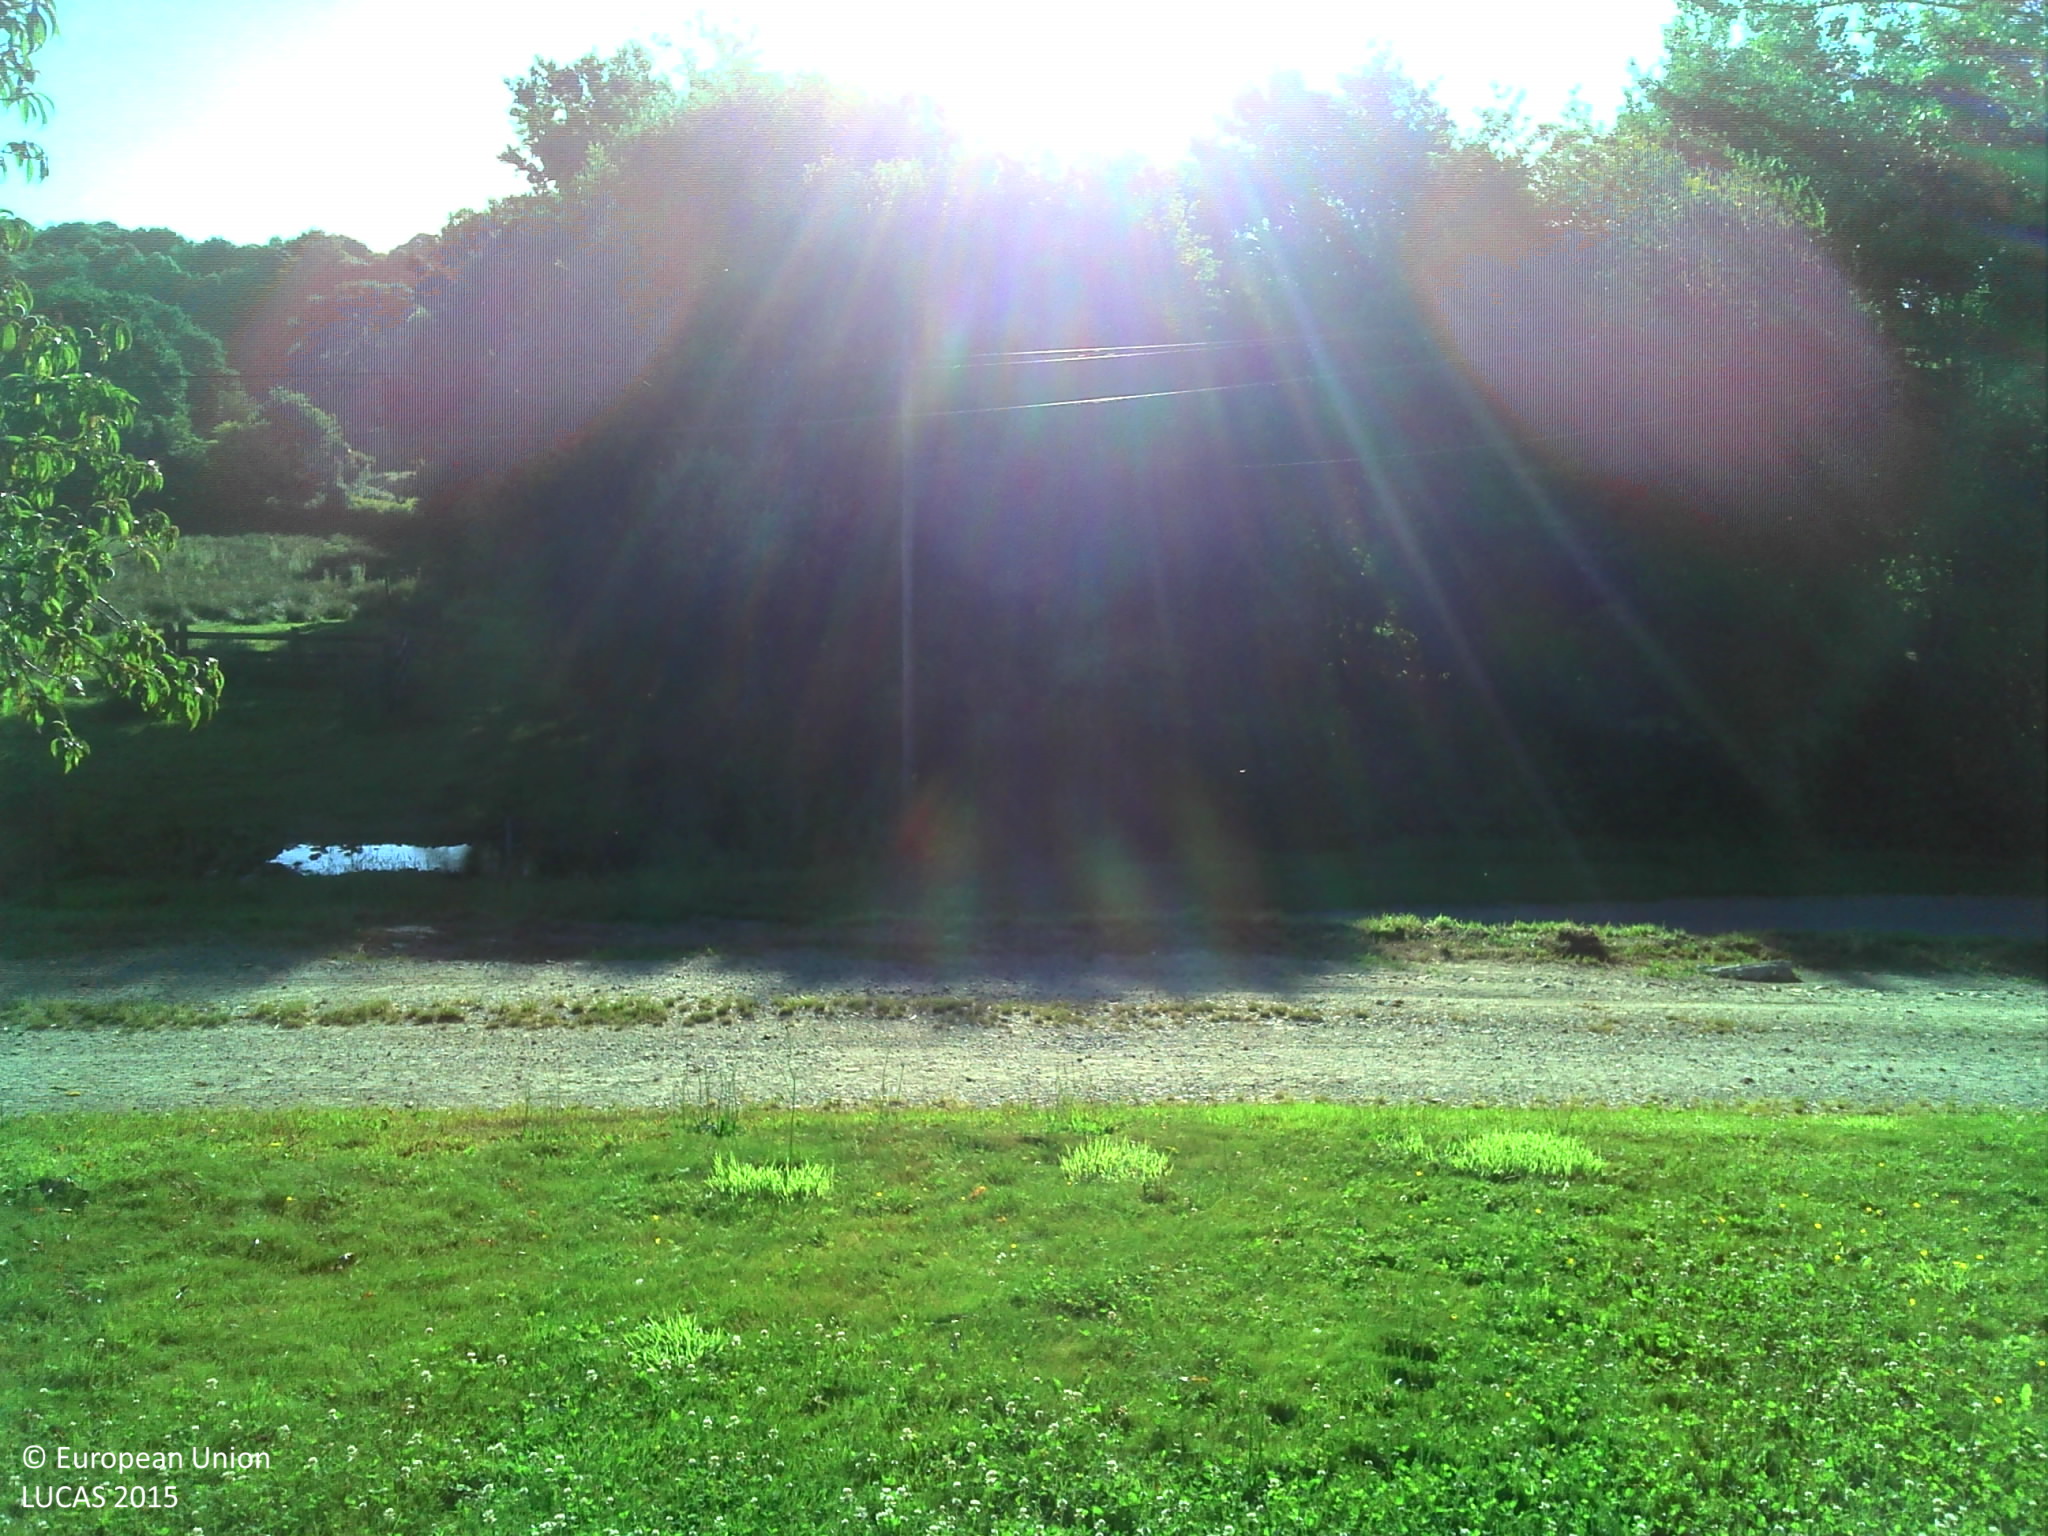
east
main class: Grassland
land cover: Grassland with sparse tree/shrub cover
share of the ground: > 75 %
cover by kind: herbaceous plants 95 %, broadleaved forest trees 5 %
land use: Residential
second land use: Agriculture (excluding fallow land and kitchen gardens)
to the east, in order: Grassland with sparse tree/shrub cover; Tracks; Electric lines; Ditches and canals; Grass margins; Paved roads, cycling and walking lanes; Grass margins; Rivers and streams; Broadleaved woodland; Grassland with sparse tree/shrub cover; Ditches and canals; Grassland with sparse tree/shrub cover; Broadleaved woodland; Grassland without tree/shrub cover; Lines of trees; Grassland without tree/shrub cover
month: June
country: FR
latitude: 48.5059
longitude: -1.5390
